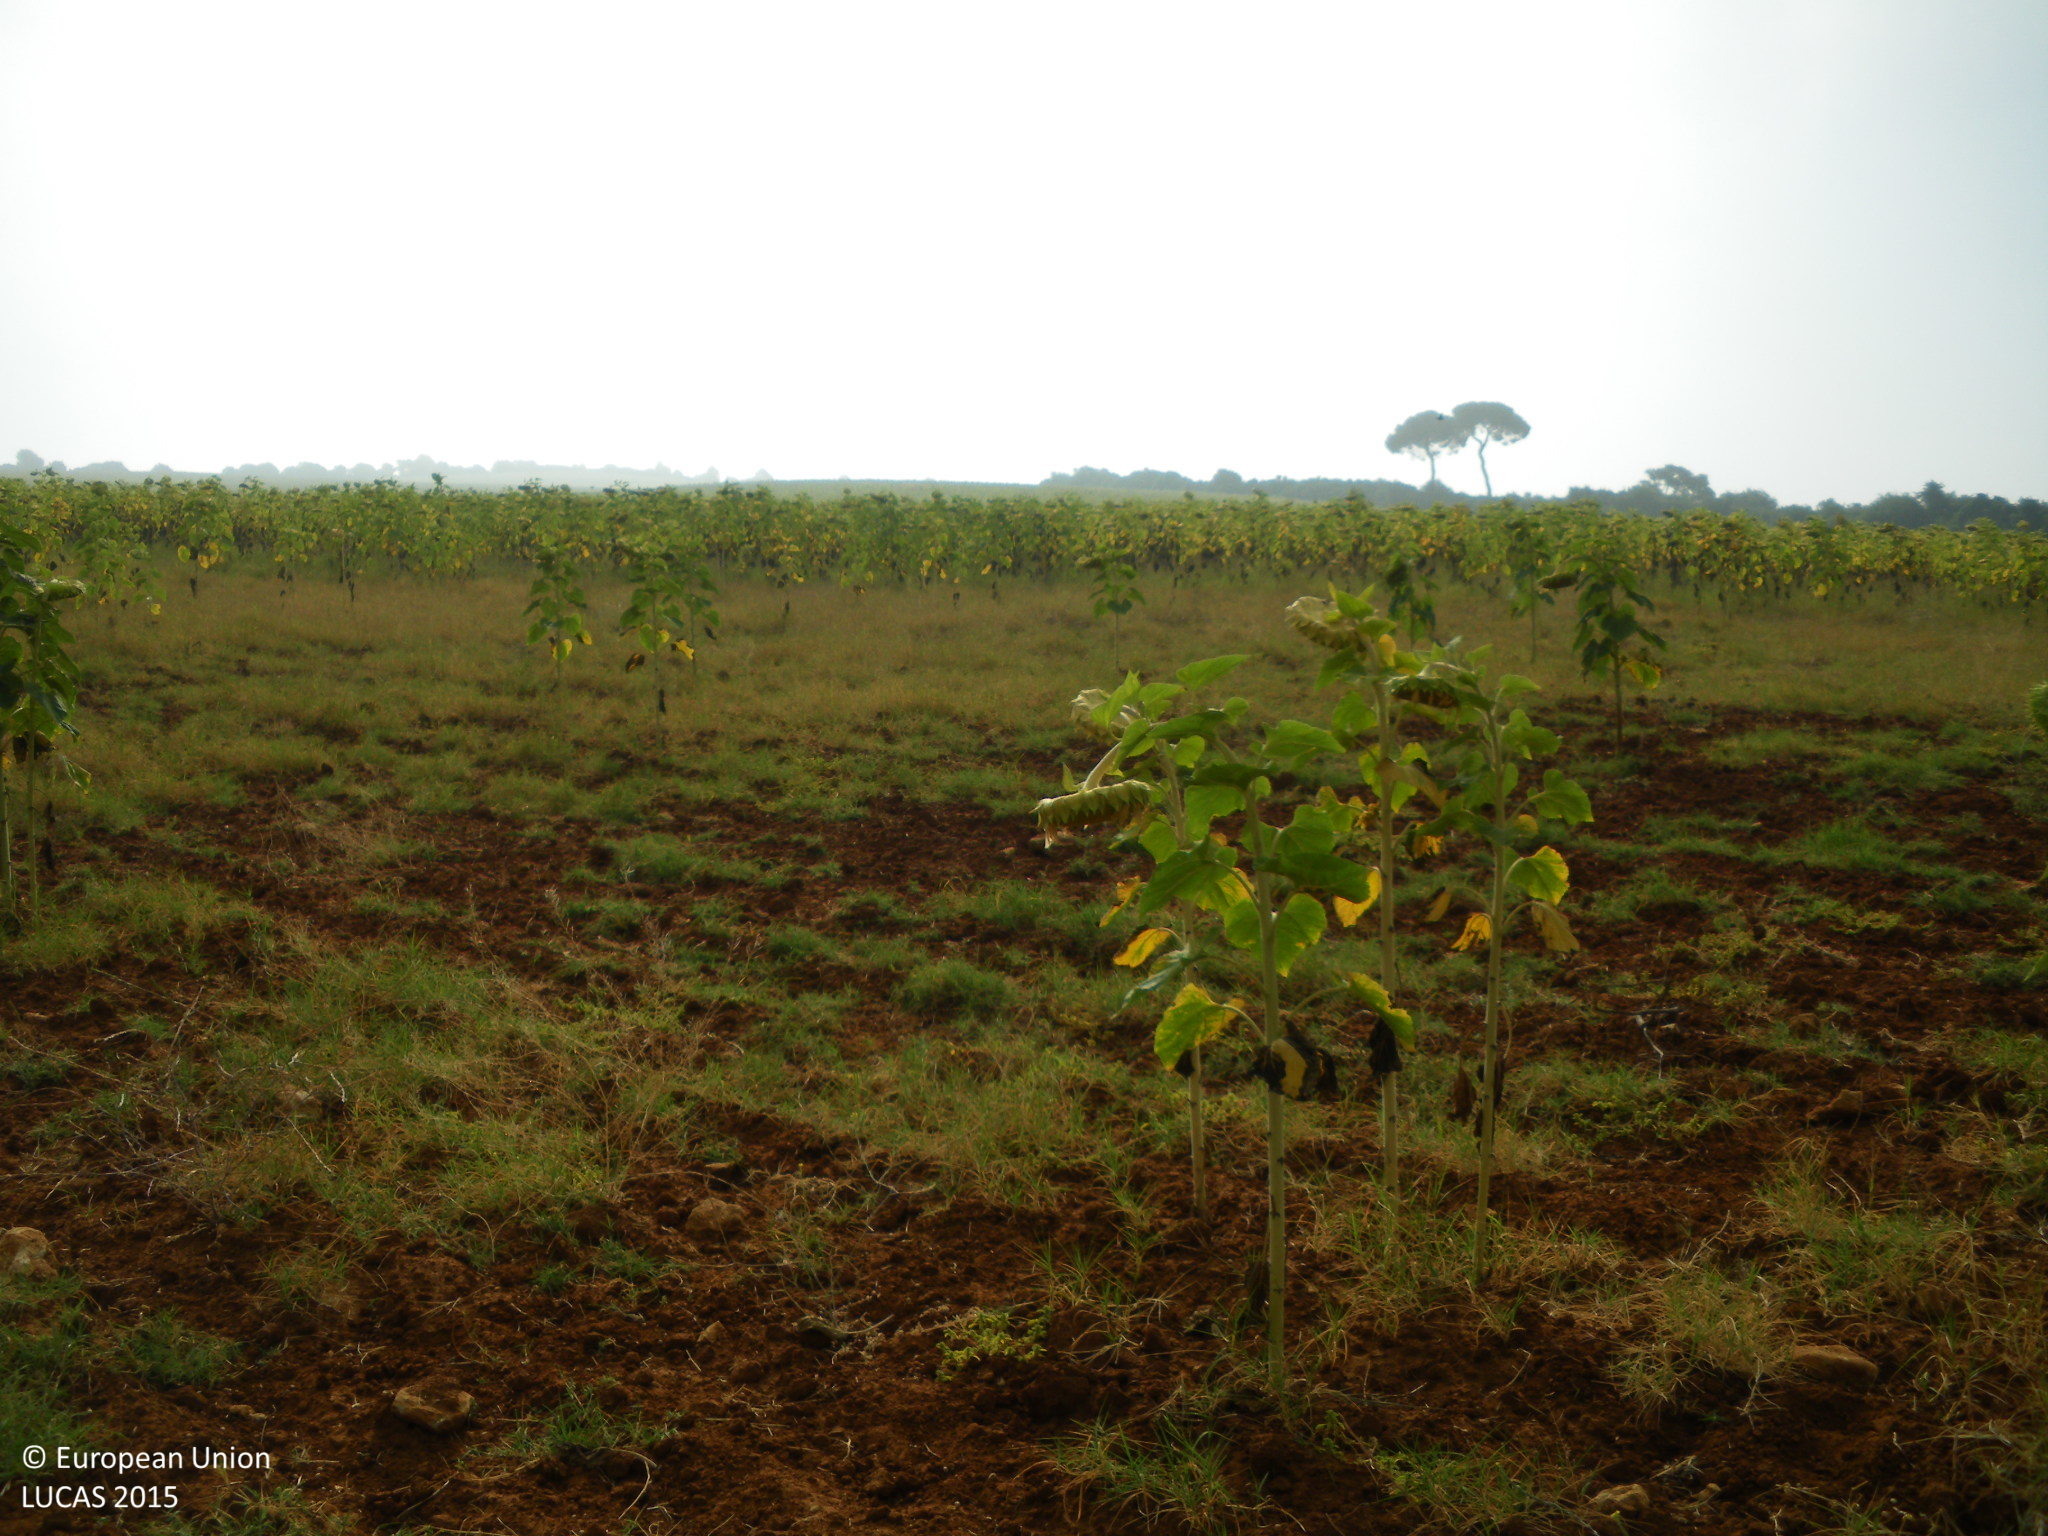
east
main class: Cropland
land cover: Sunflower
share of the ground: < 10 %
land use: Agriculture (excluding fallow land and kitchen gardens)
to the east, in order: Sunflower
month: July
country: ES
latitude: 36.7409
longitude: -5.7420
